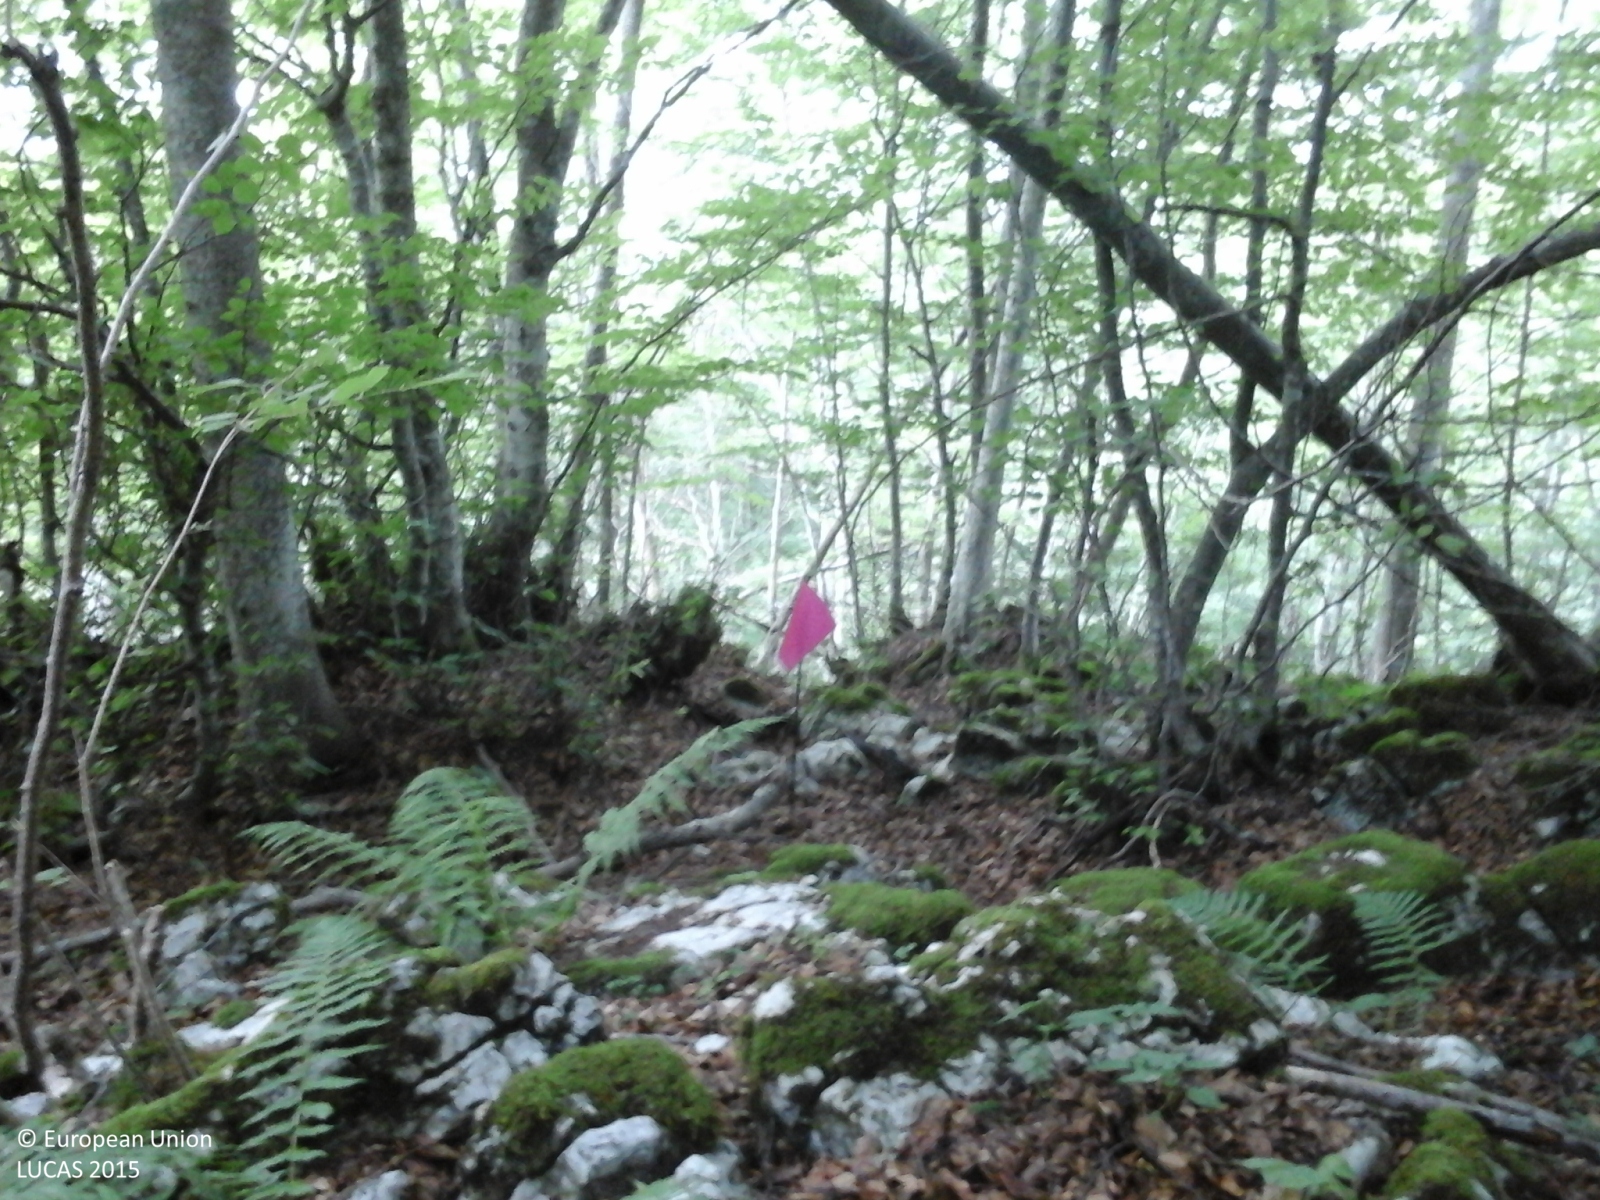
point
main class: Woodland
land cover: Broadleaved woodland
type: mountainous beech forest
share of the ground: > 75 %
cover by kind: broadleaved forest trees 100 %
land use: Forestry
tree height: > 5 m
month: June
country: IT
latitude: 45.8522
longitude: 11.6331
